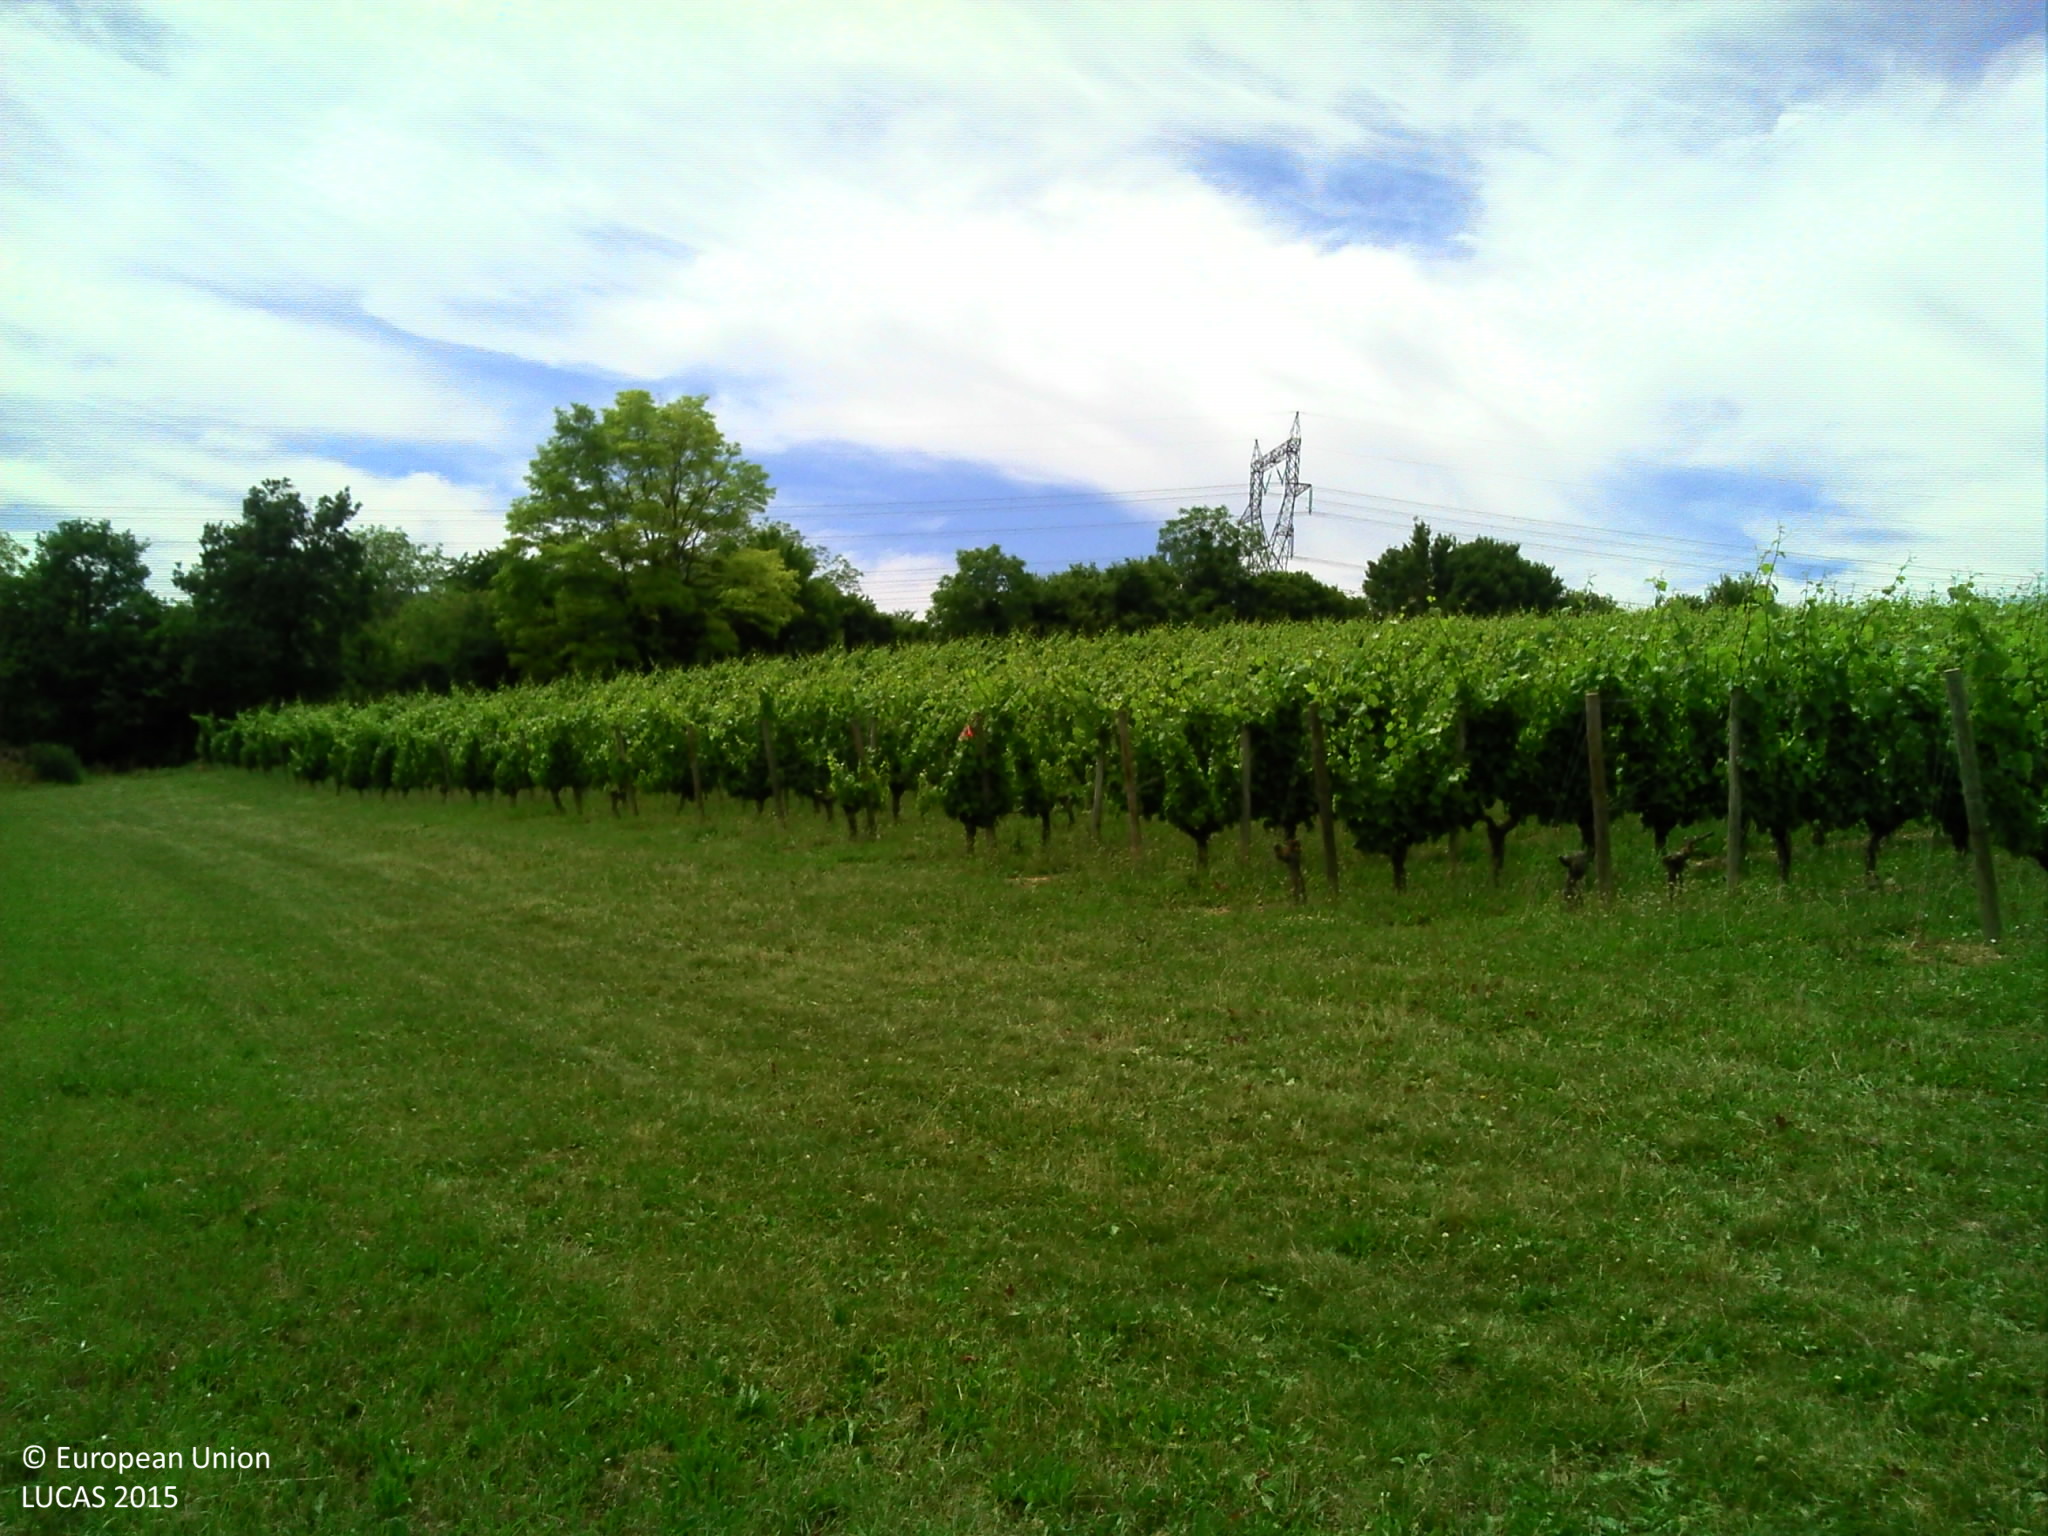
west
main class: Cropland
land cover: Common wheat
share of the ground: > 75 %
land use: Agriculture (excluding fallow land and kitchen gardens)
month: June
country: FR
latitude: 46.3191
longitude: 3.2582
